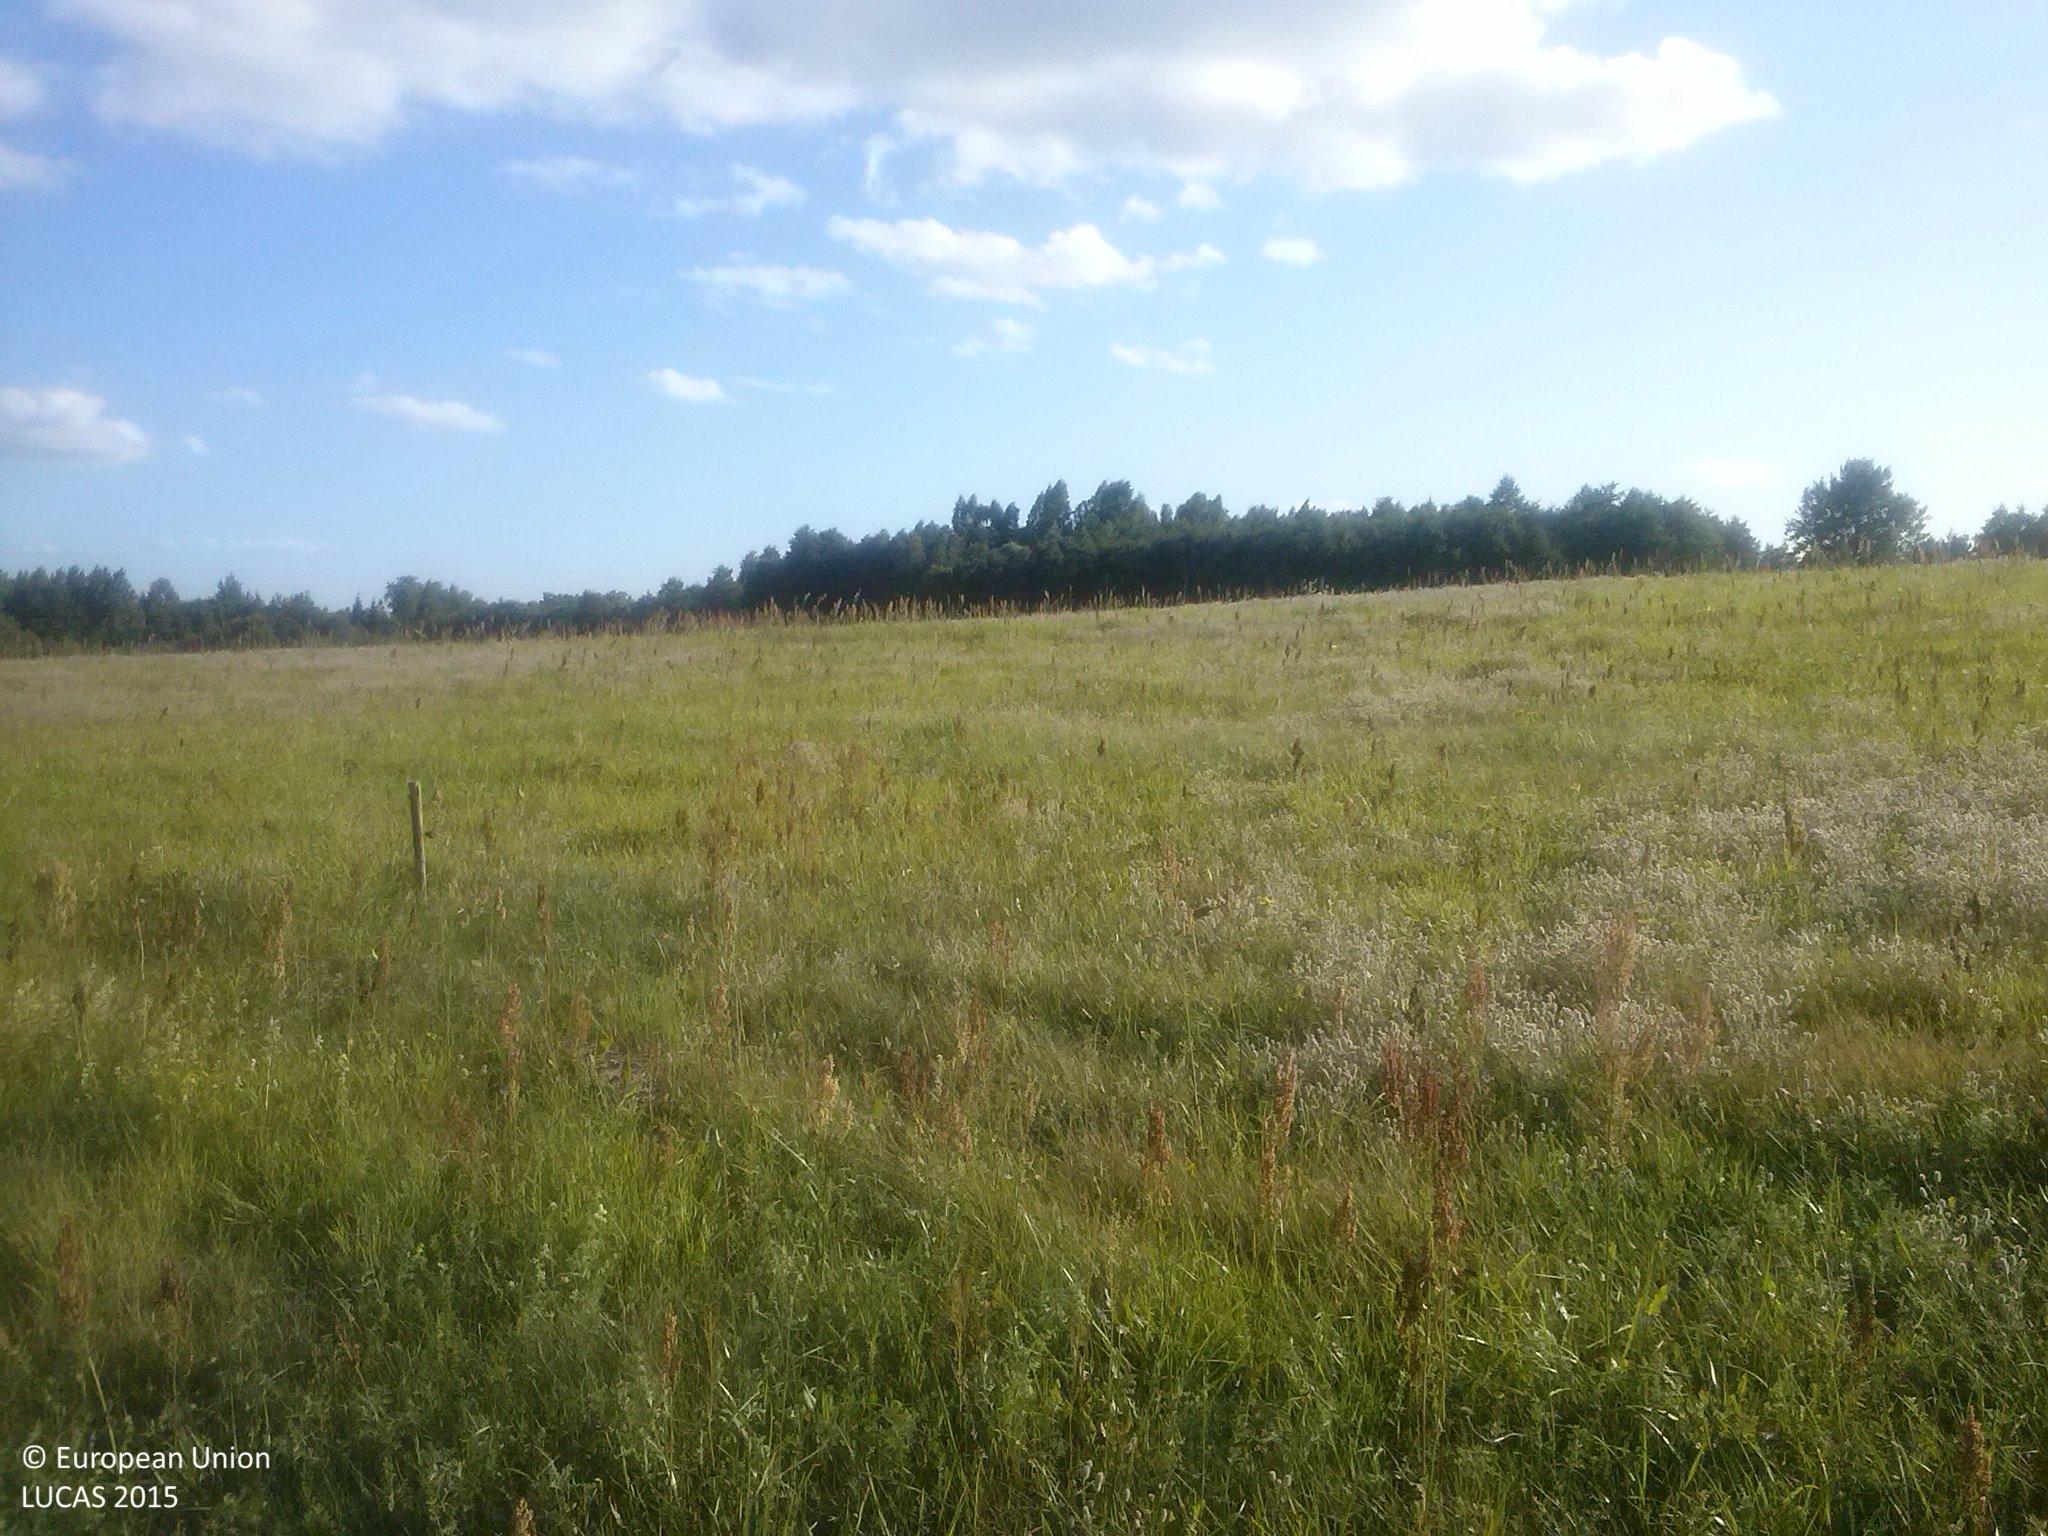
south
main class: Grassland
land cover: Grassland without tree/shrub cover
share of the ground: > 75 %
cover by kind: herbaceous plants 100 %
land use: Agriculture (excluding fallow land and kitchen gardens)
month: August
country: LV
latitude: 56.1518
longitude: 26.8206
